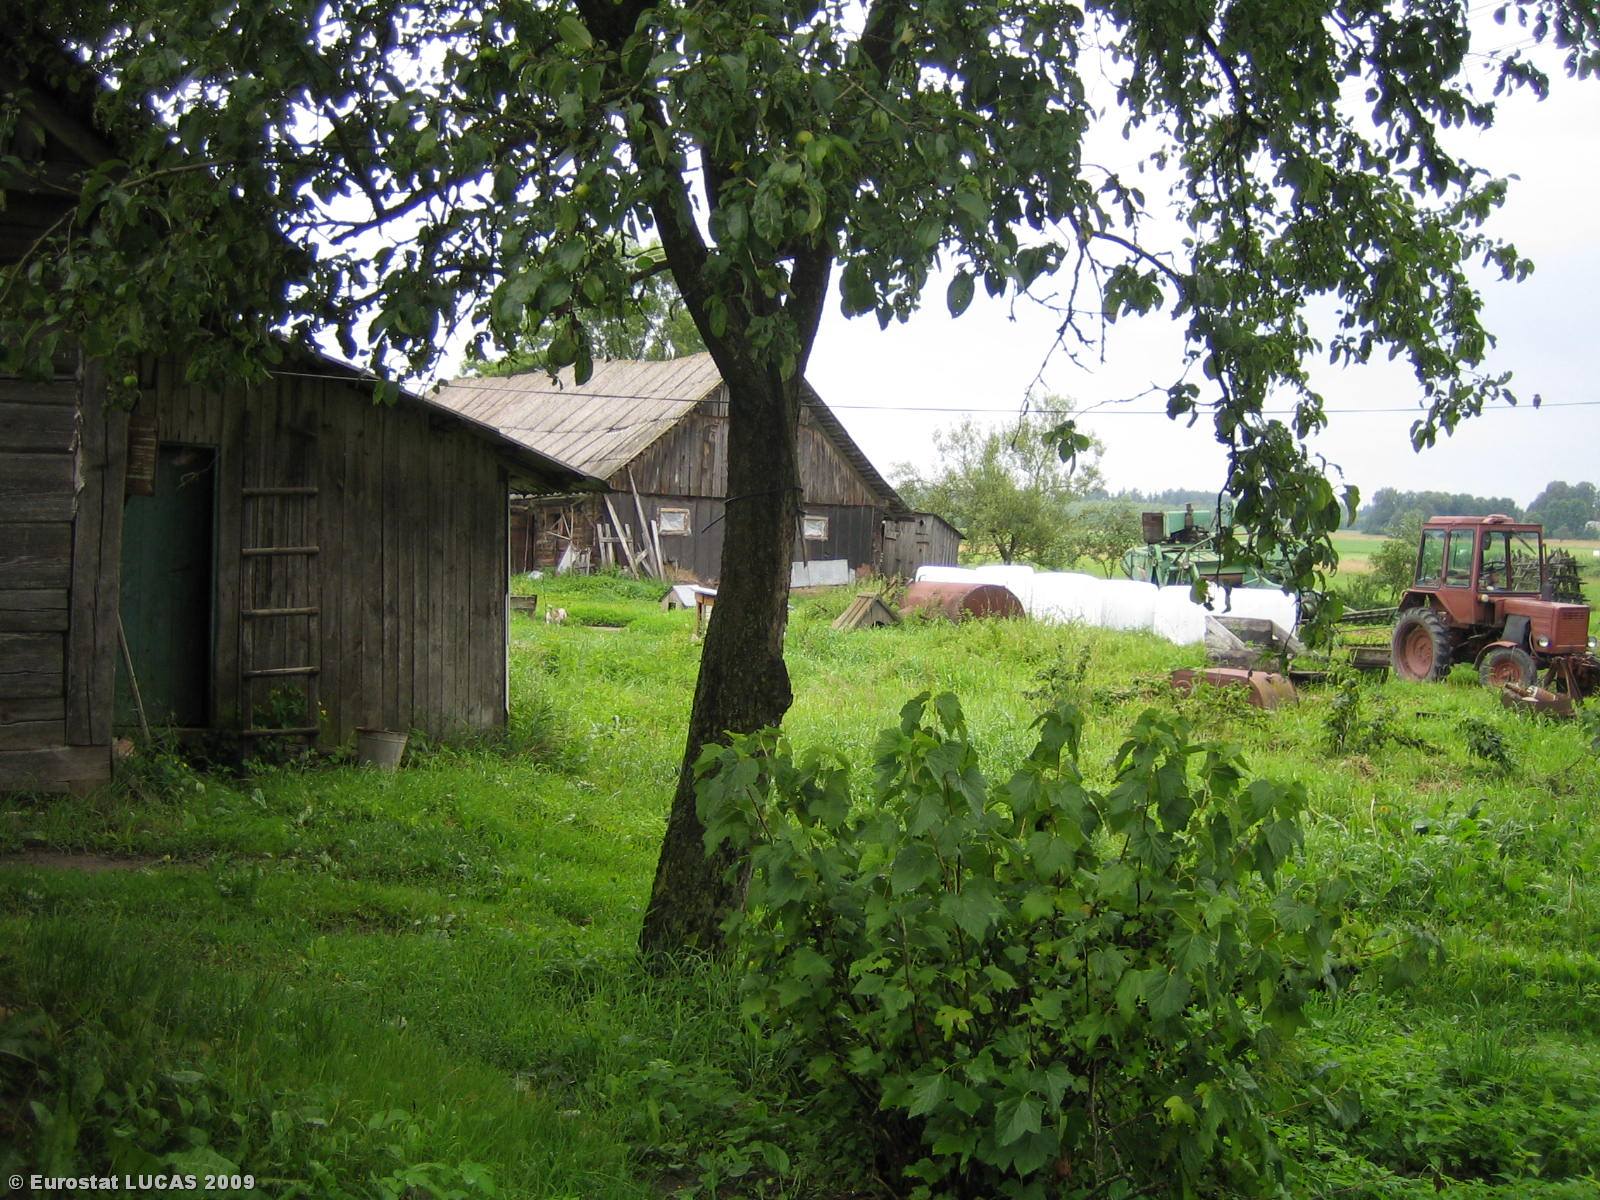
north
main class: Grassland
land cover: Grassland without tree/shrub cover
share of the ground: > 75 %
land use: Agriculture (excluding fallow land and kitchen gardens)
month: July
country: LT
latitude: 55.6563
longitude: 25.5255
